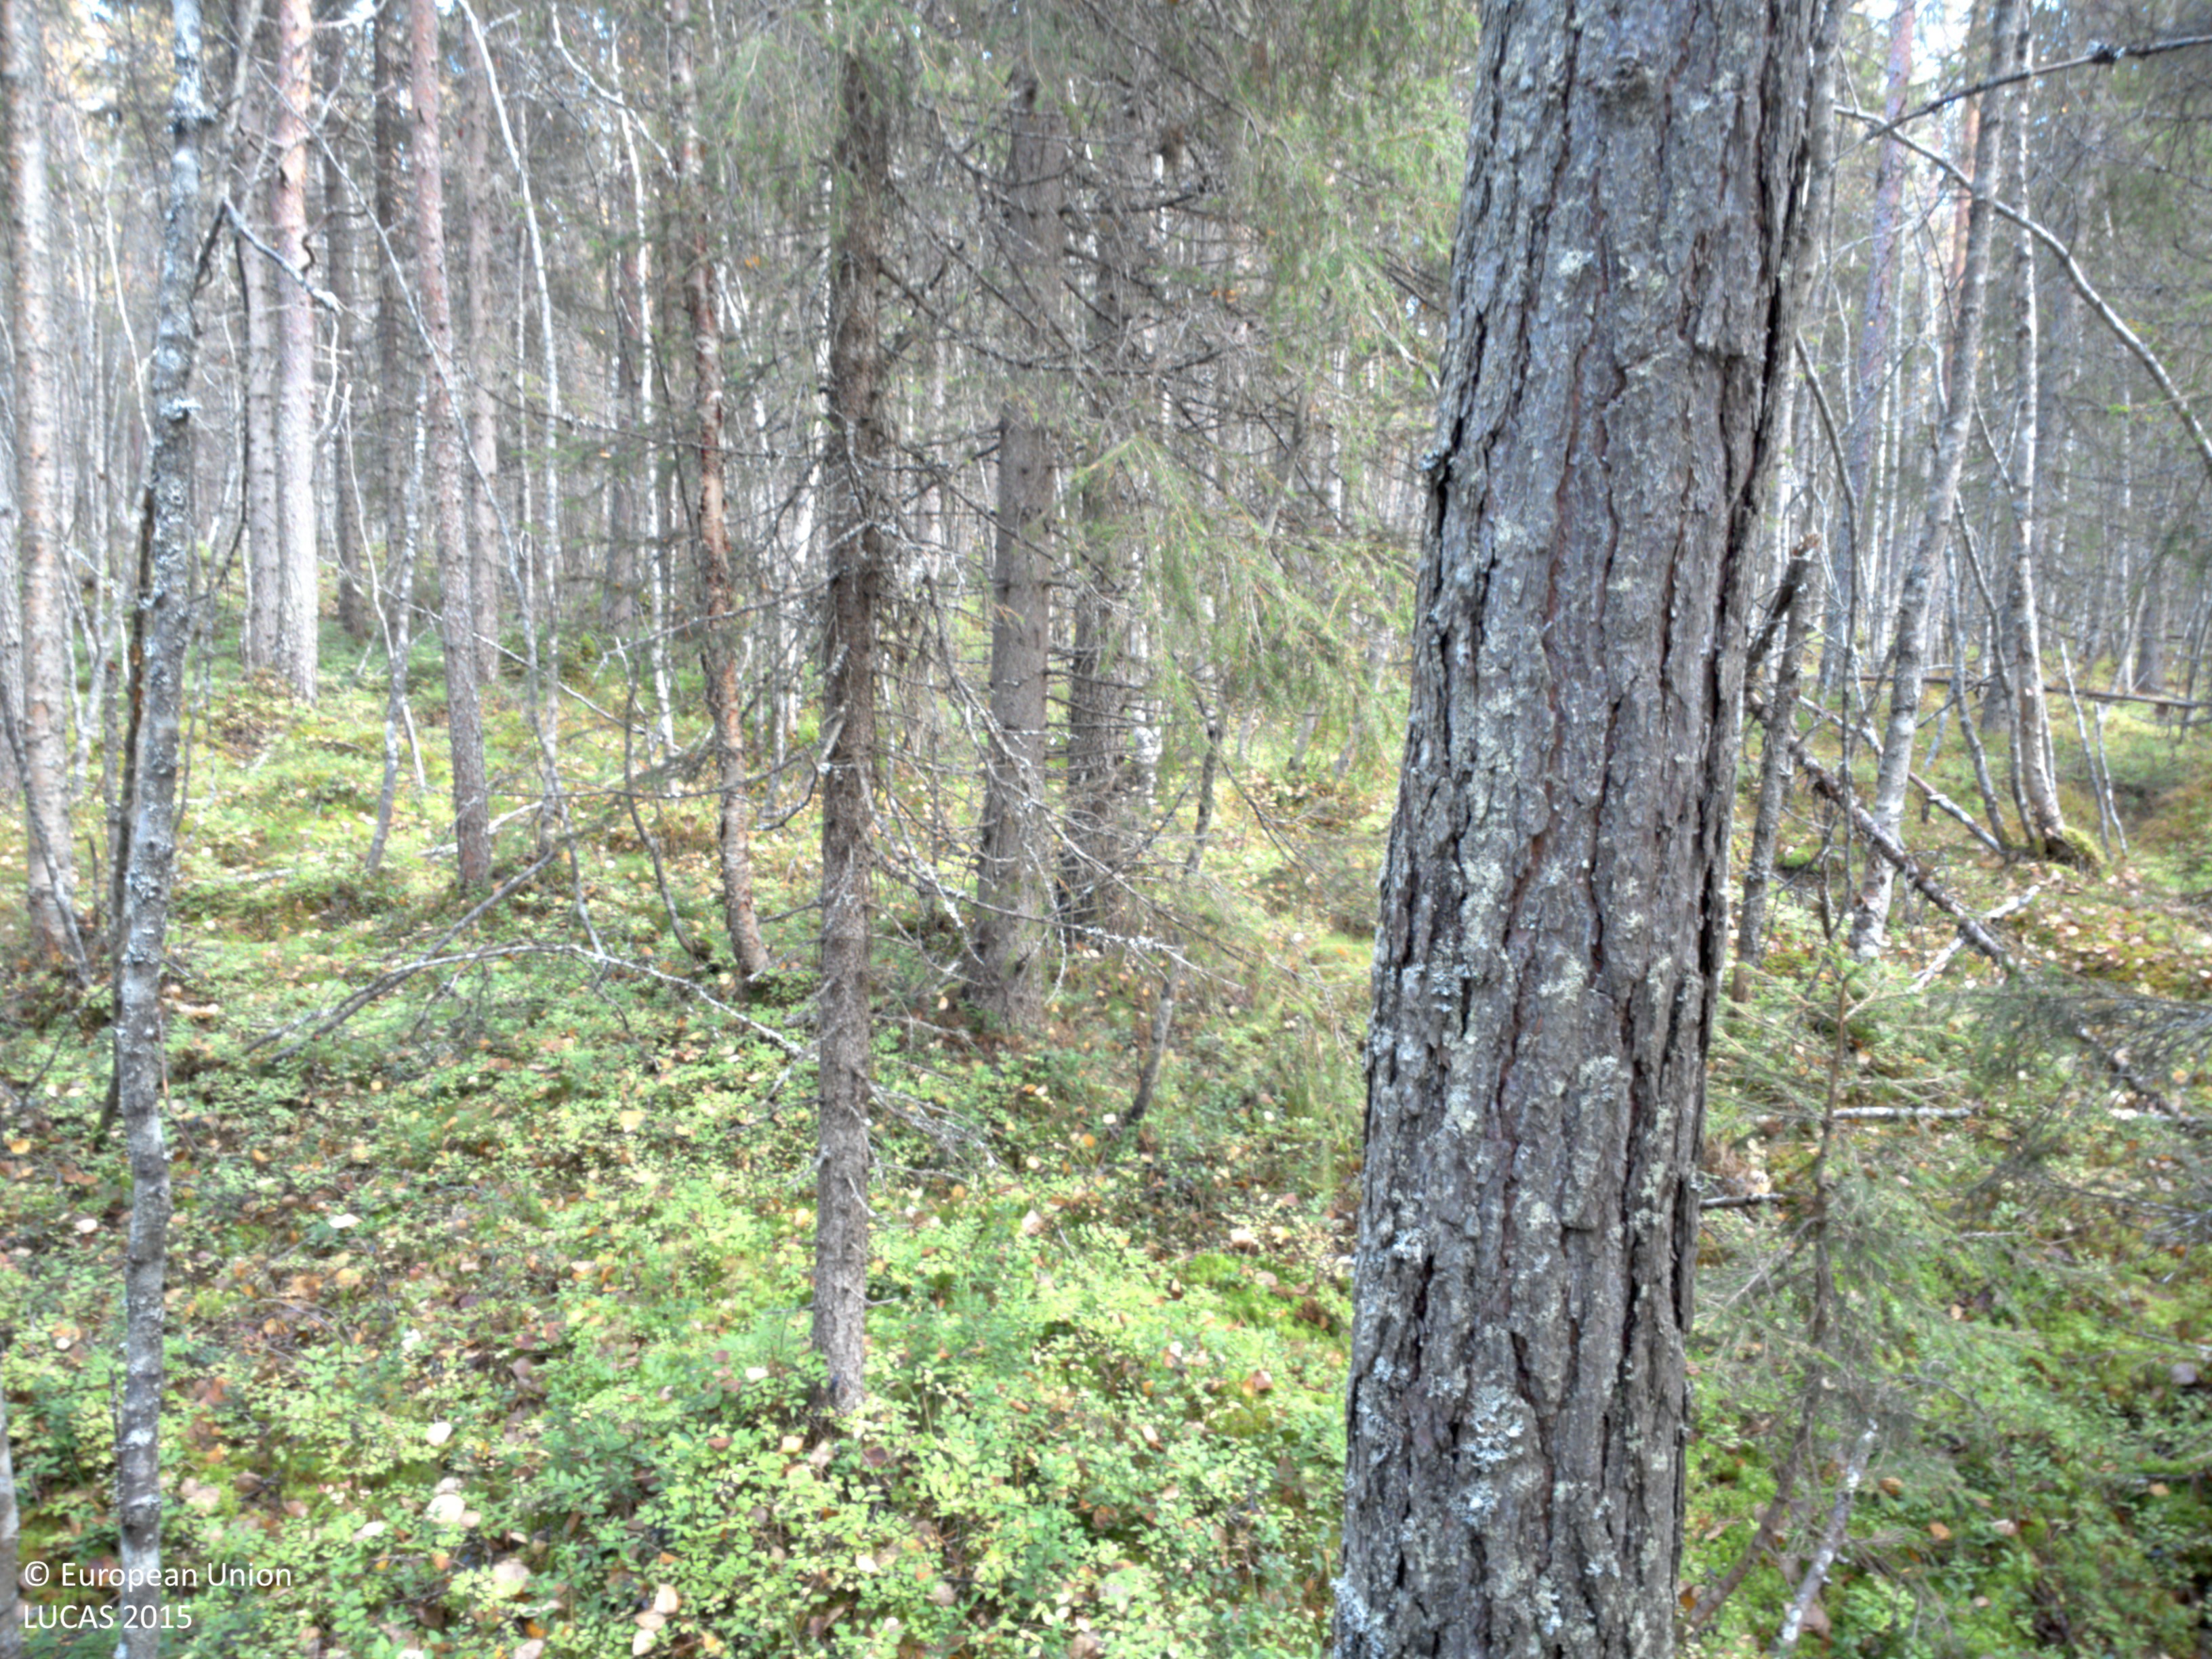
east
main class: Woodland
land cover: Spruce dominated coniferous woodland
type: boreal forest
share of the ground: > 75 %
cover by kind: coniferous forest trees 80 %, shrubs 10 %, broadleaved forest trees 5 %, lichens and mosses 5 %
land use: Forestry
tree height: > 5 m
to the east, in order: Spruce dominated coniferous woodland; Spruce dominated mixed woodland; Pine dominated mixed woodland; Rivers and streams; Pine dominated mixed woodland; Rivers and streams; Pine dominated mixed woodland
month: September
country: SE
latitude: 65.0841
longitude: 18.4090
